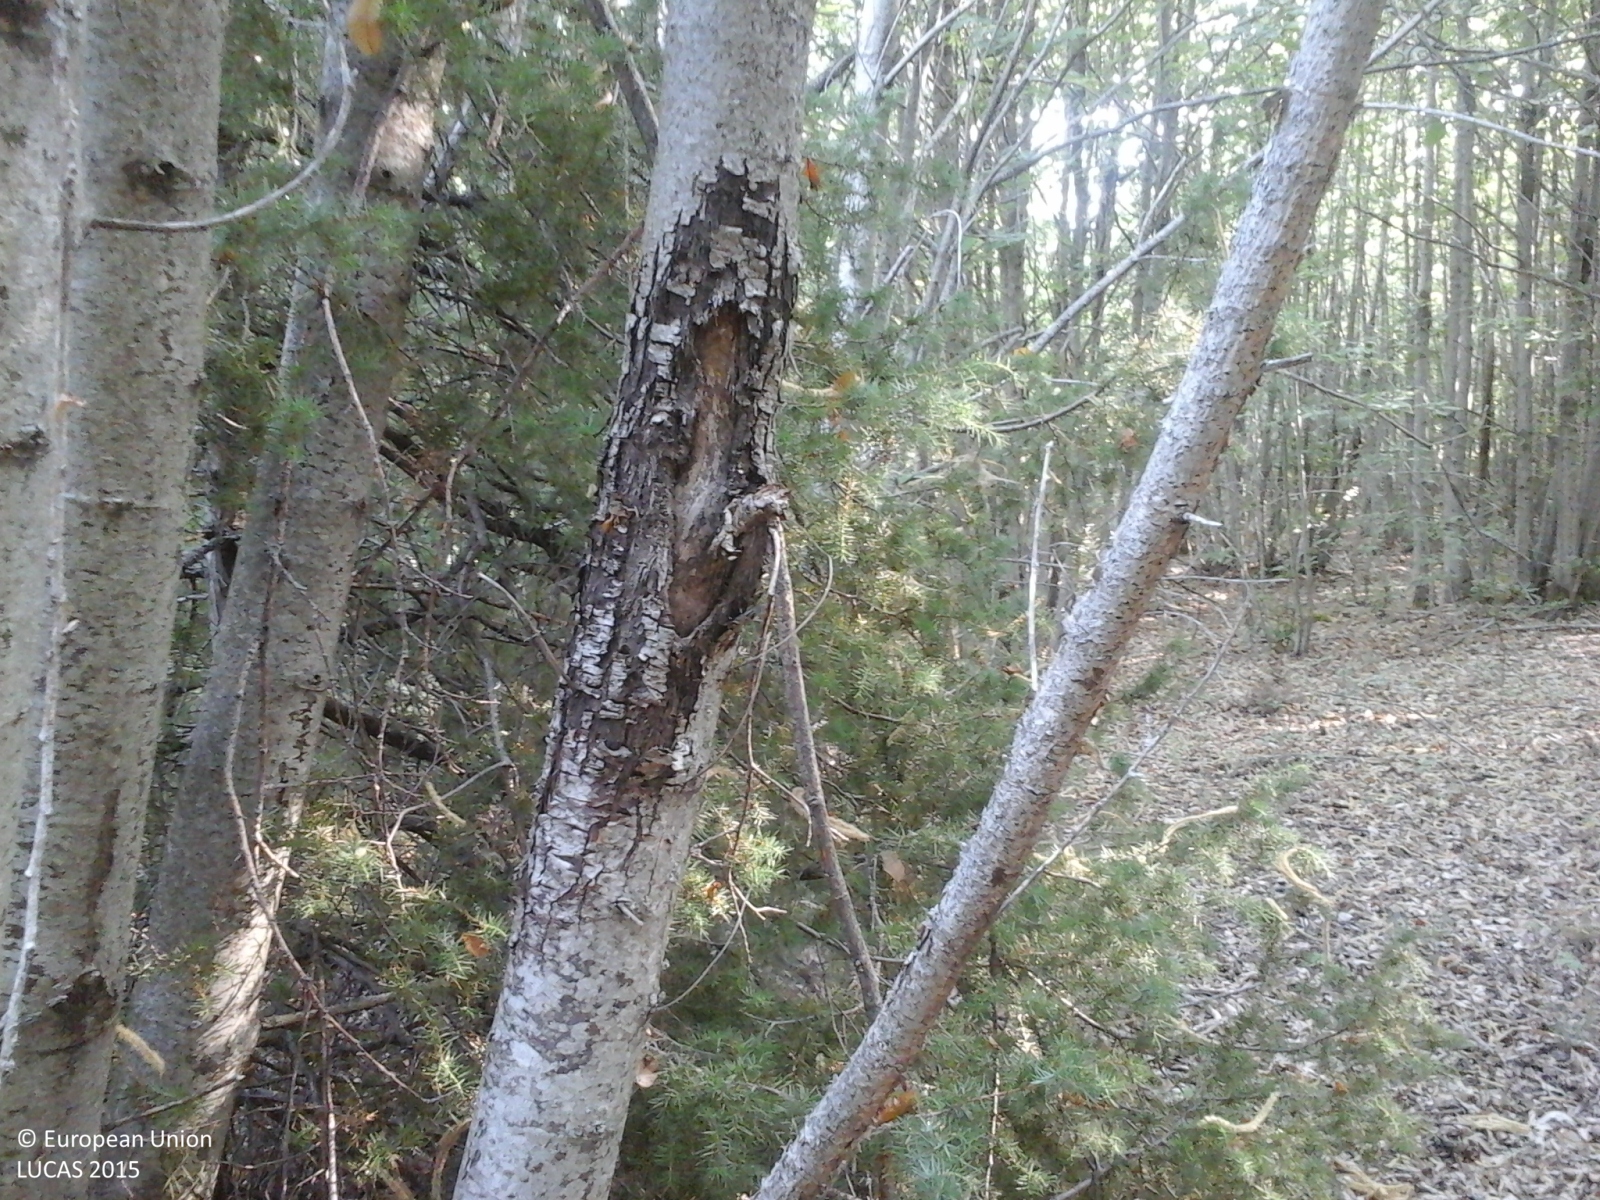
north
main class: Woodland
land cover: Broadleaved woodland
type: thermophilous deciduous forest
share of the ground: > 75 %
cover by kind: broadleaved forest trees 85 %, shrubs 10 %, herbaceous plants 5 %
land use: Forestry
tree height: > 5 m
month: July
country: IT
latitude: 42.8946
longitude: 11.5747
